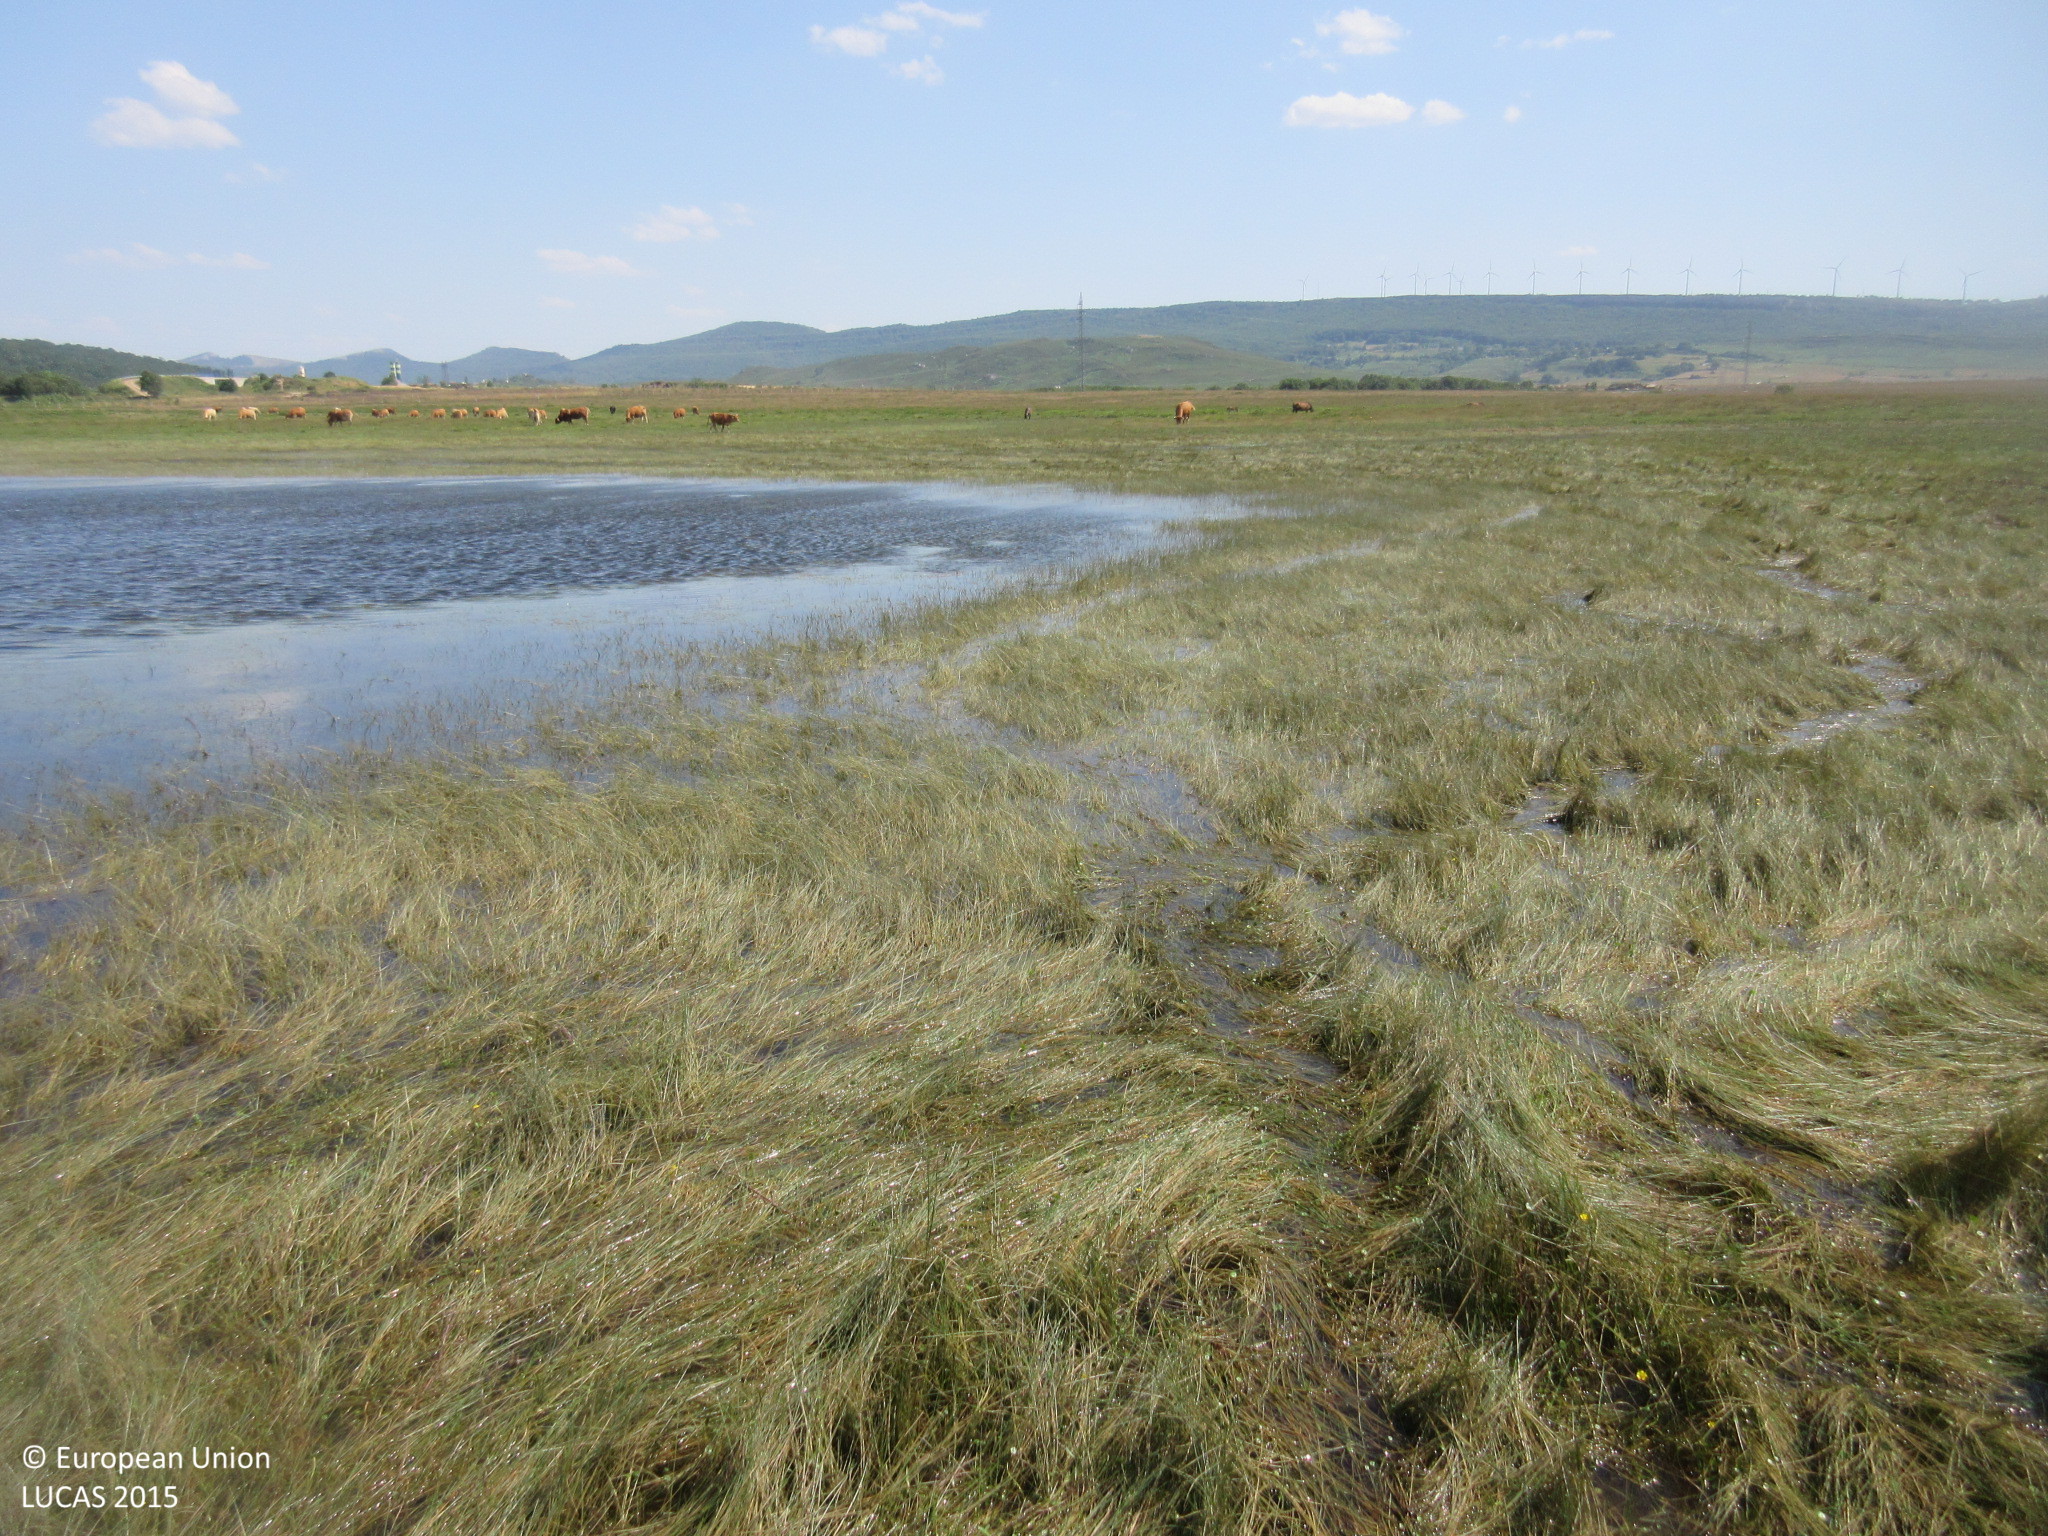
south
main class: Grassland
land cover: Grassland without tree/shrub cover
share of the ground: > 75 %
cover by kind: herbaceous plants 100 %
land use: Agriculture (excluding fallow land and kitchen gardens)
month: July
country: ES
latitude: 42.9935
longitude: -3.8688
